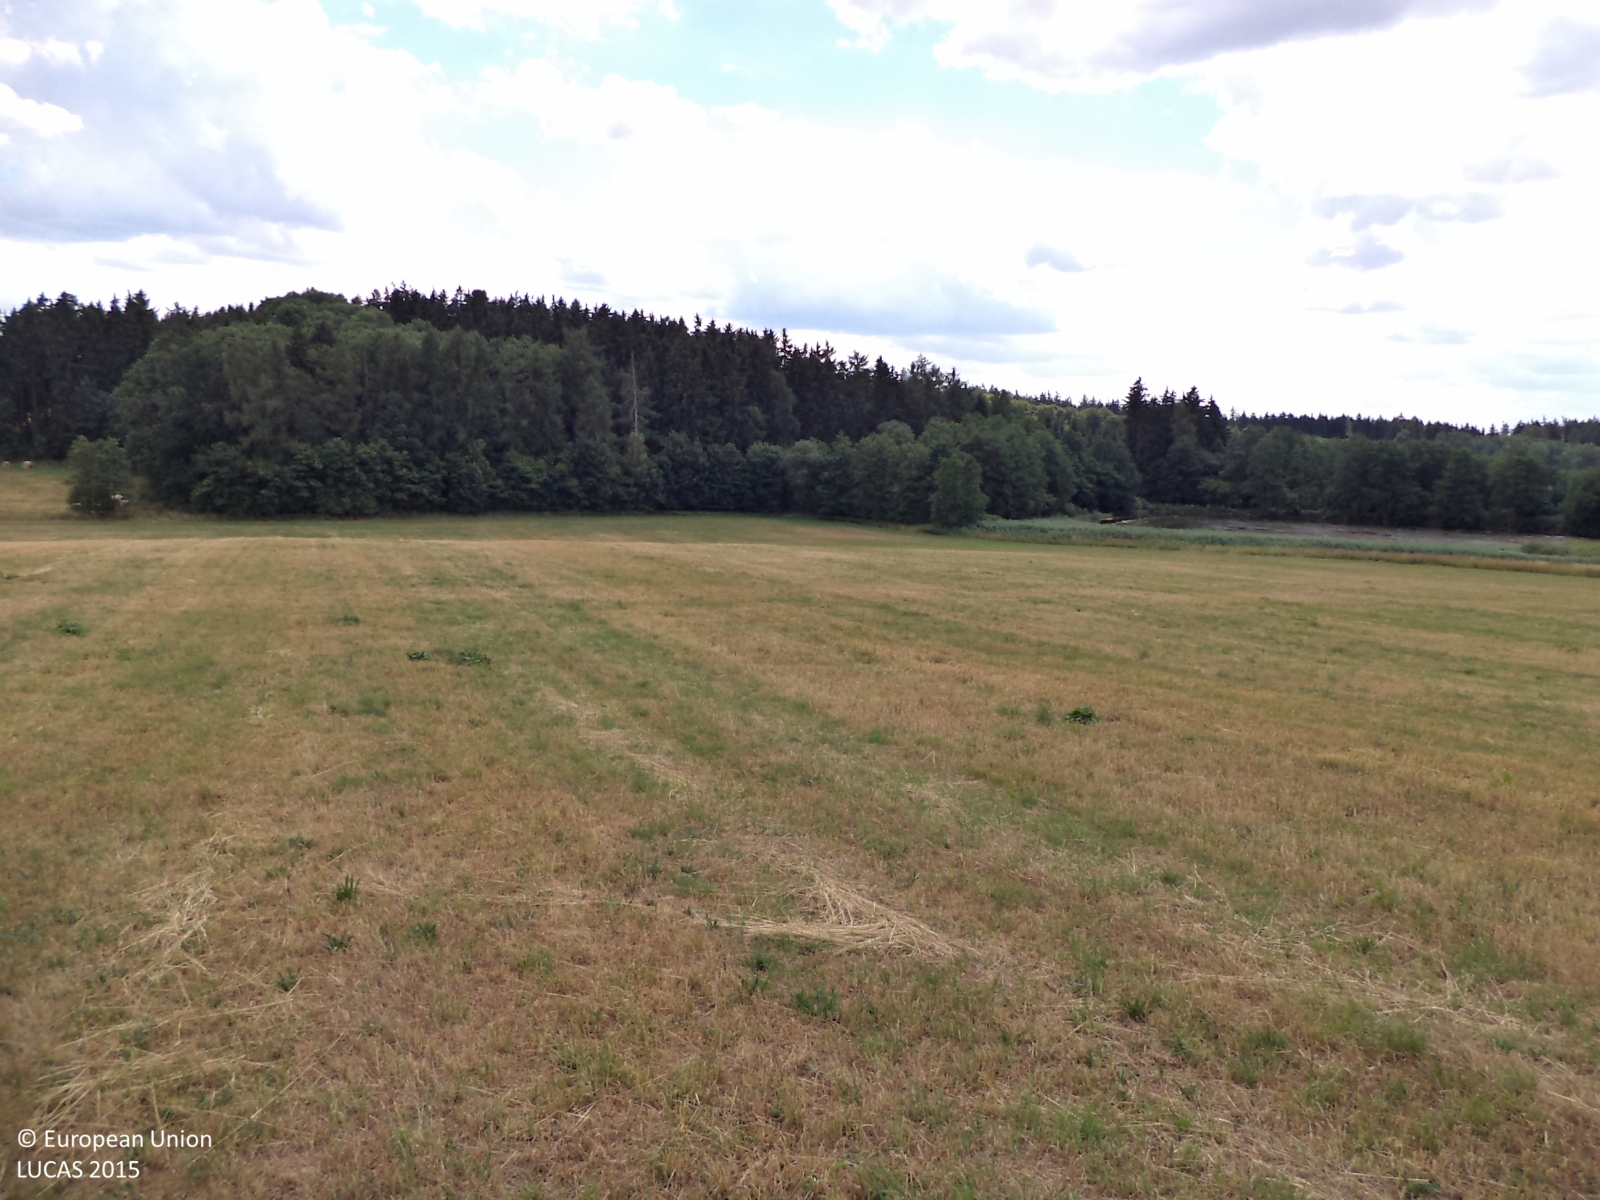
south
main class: Grassland
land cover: Grassland without tree/shrub cover
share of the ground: > 75 %
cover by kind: herbaceous plants 100 %
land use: Agriculture (excluding fallow land and kitchen gardens)
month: July
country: CZ
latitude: 49.4791
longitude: 14.5977
